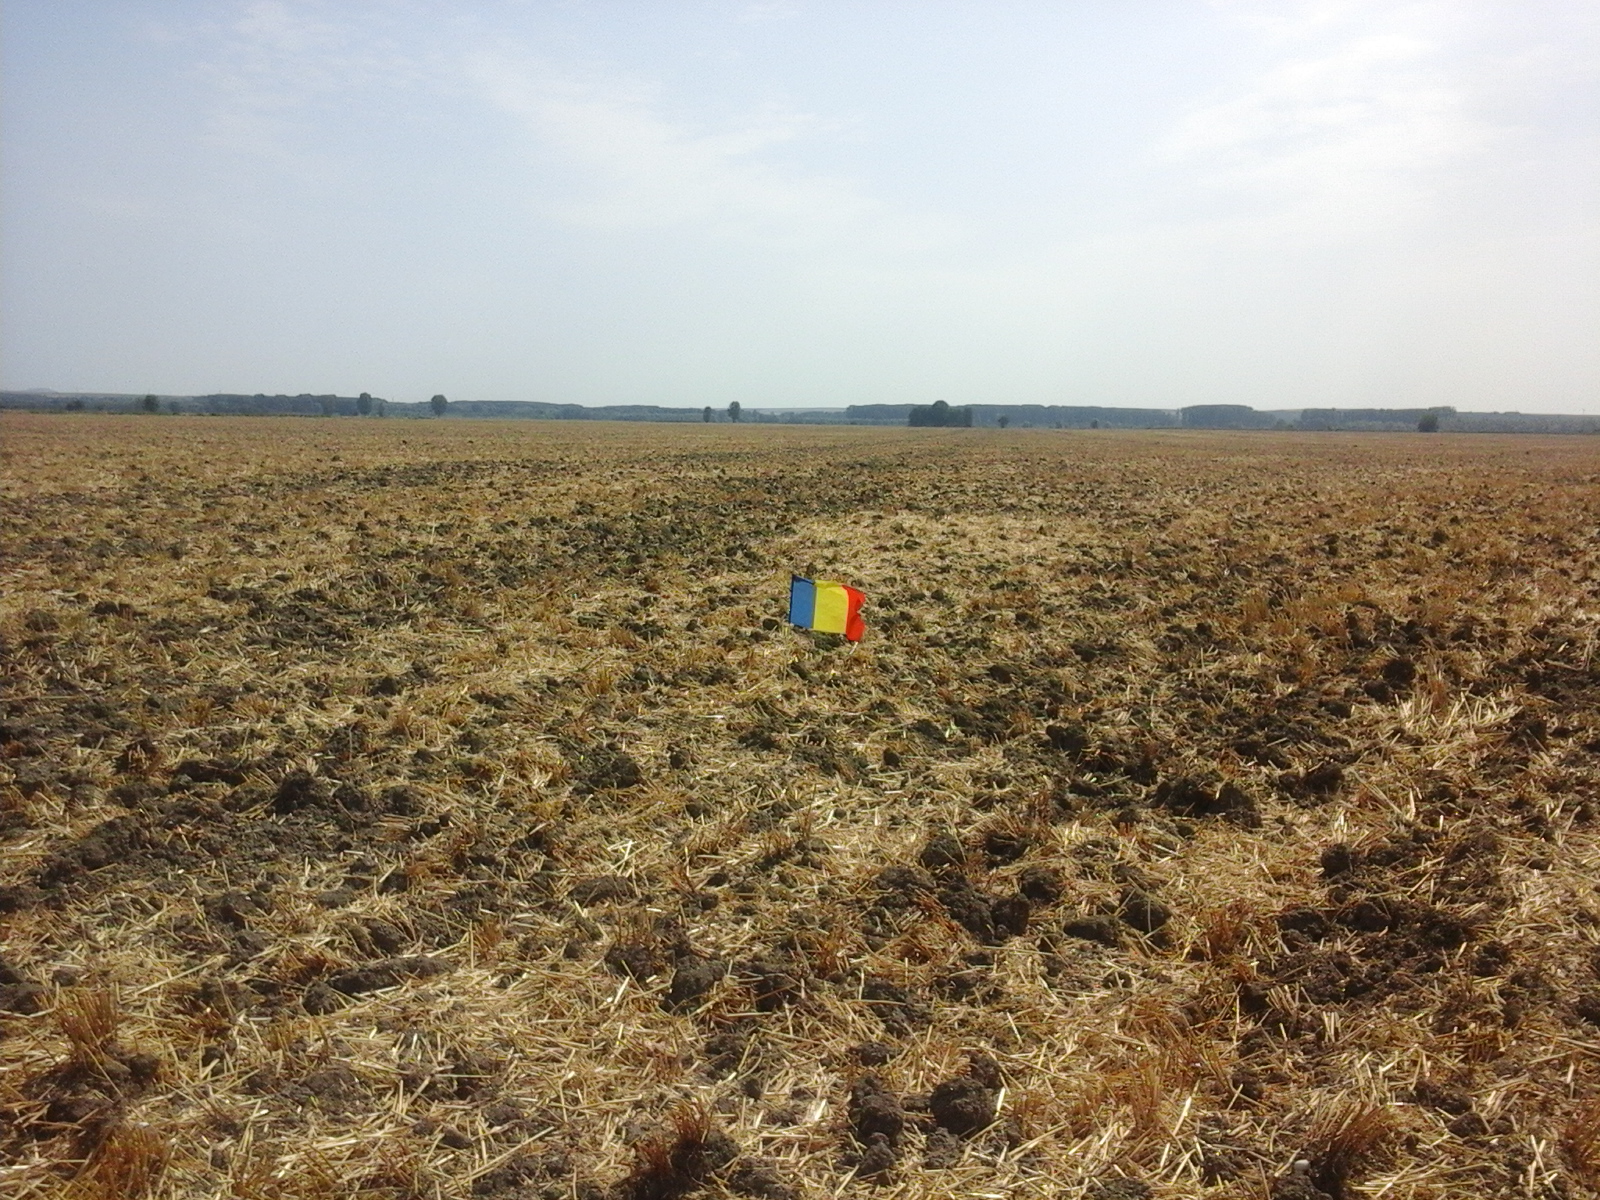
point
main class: Cropland
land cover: Common wheat
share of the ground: 25 - 50 %
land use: Agriculture (excluding fallow land and kitchen gardens)
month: July
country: RO
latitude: 44.4285
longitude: 28.0592
